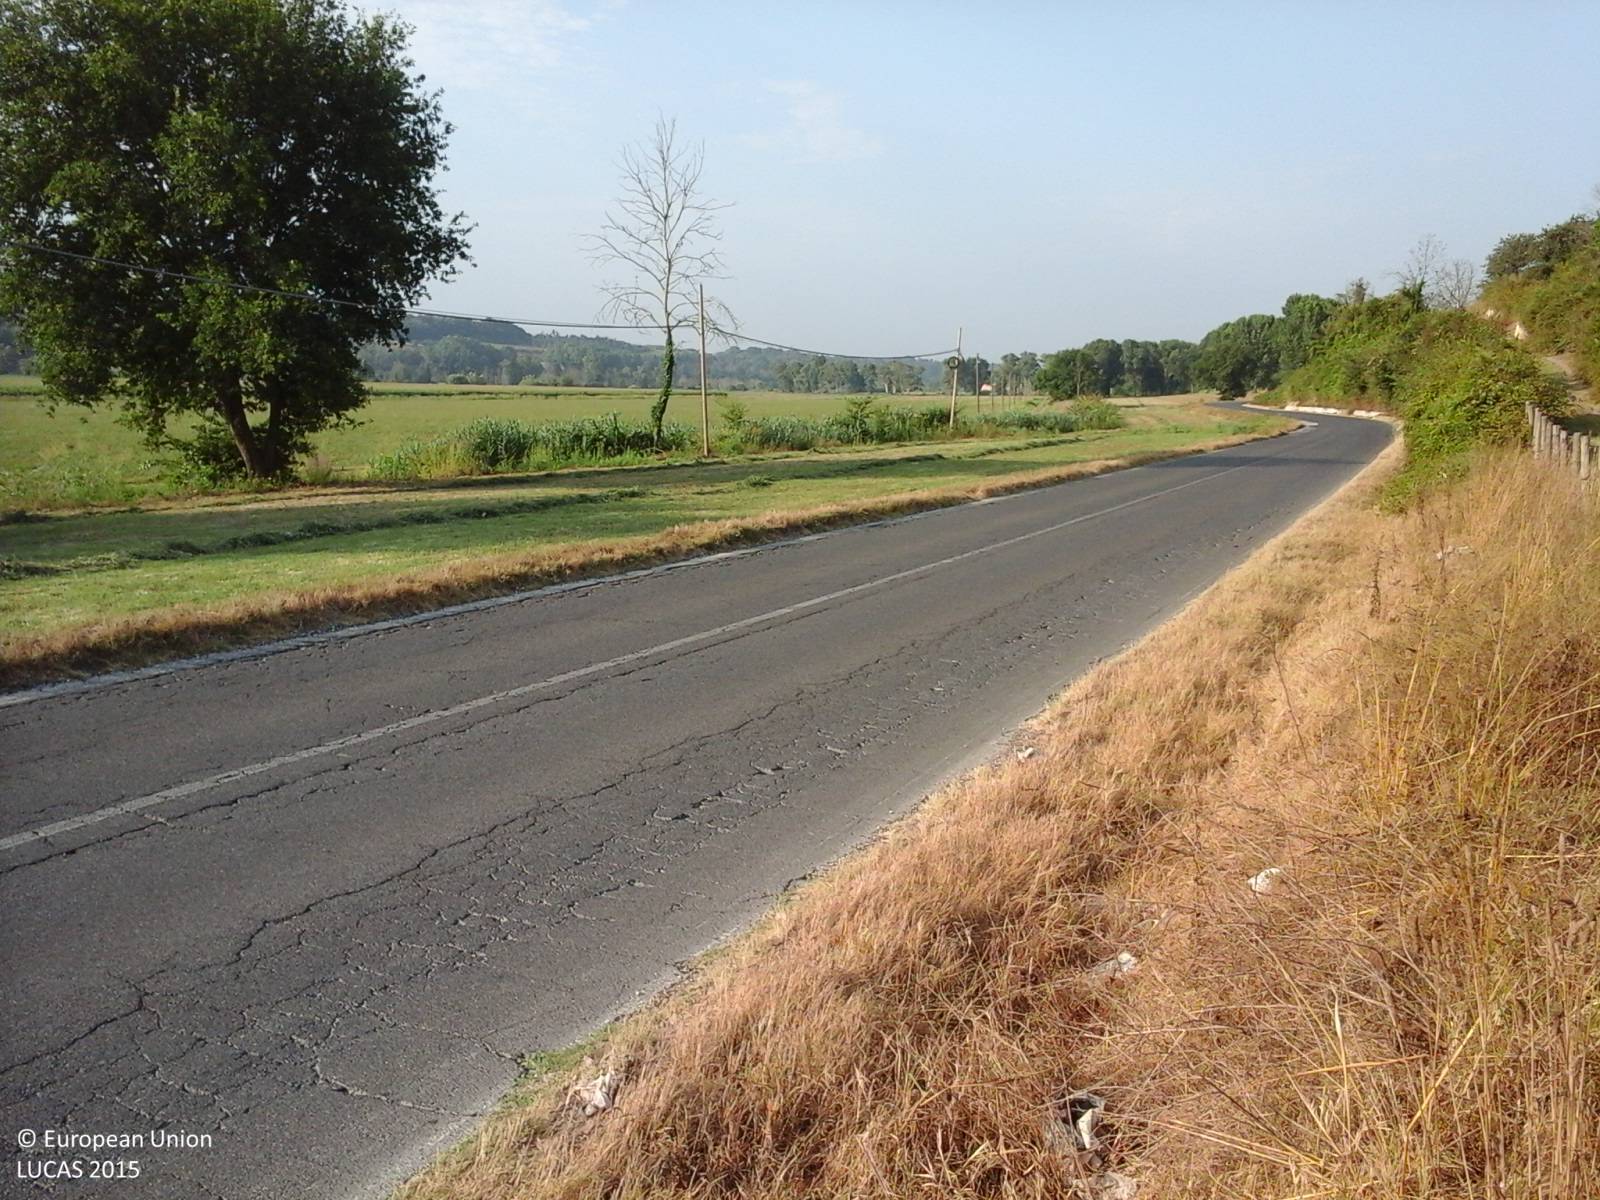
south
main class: Grassland
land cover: Grassland without tree/shrub cover
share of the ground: > 75 %
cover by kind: herbaceous plants 100 %
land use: Agriculture (excluding fallow land and kitchen gardens)
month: July
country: IT
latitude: 41.9237
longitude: 12.2705
